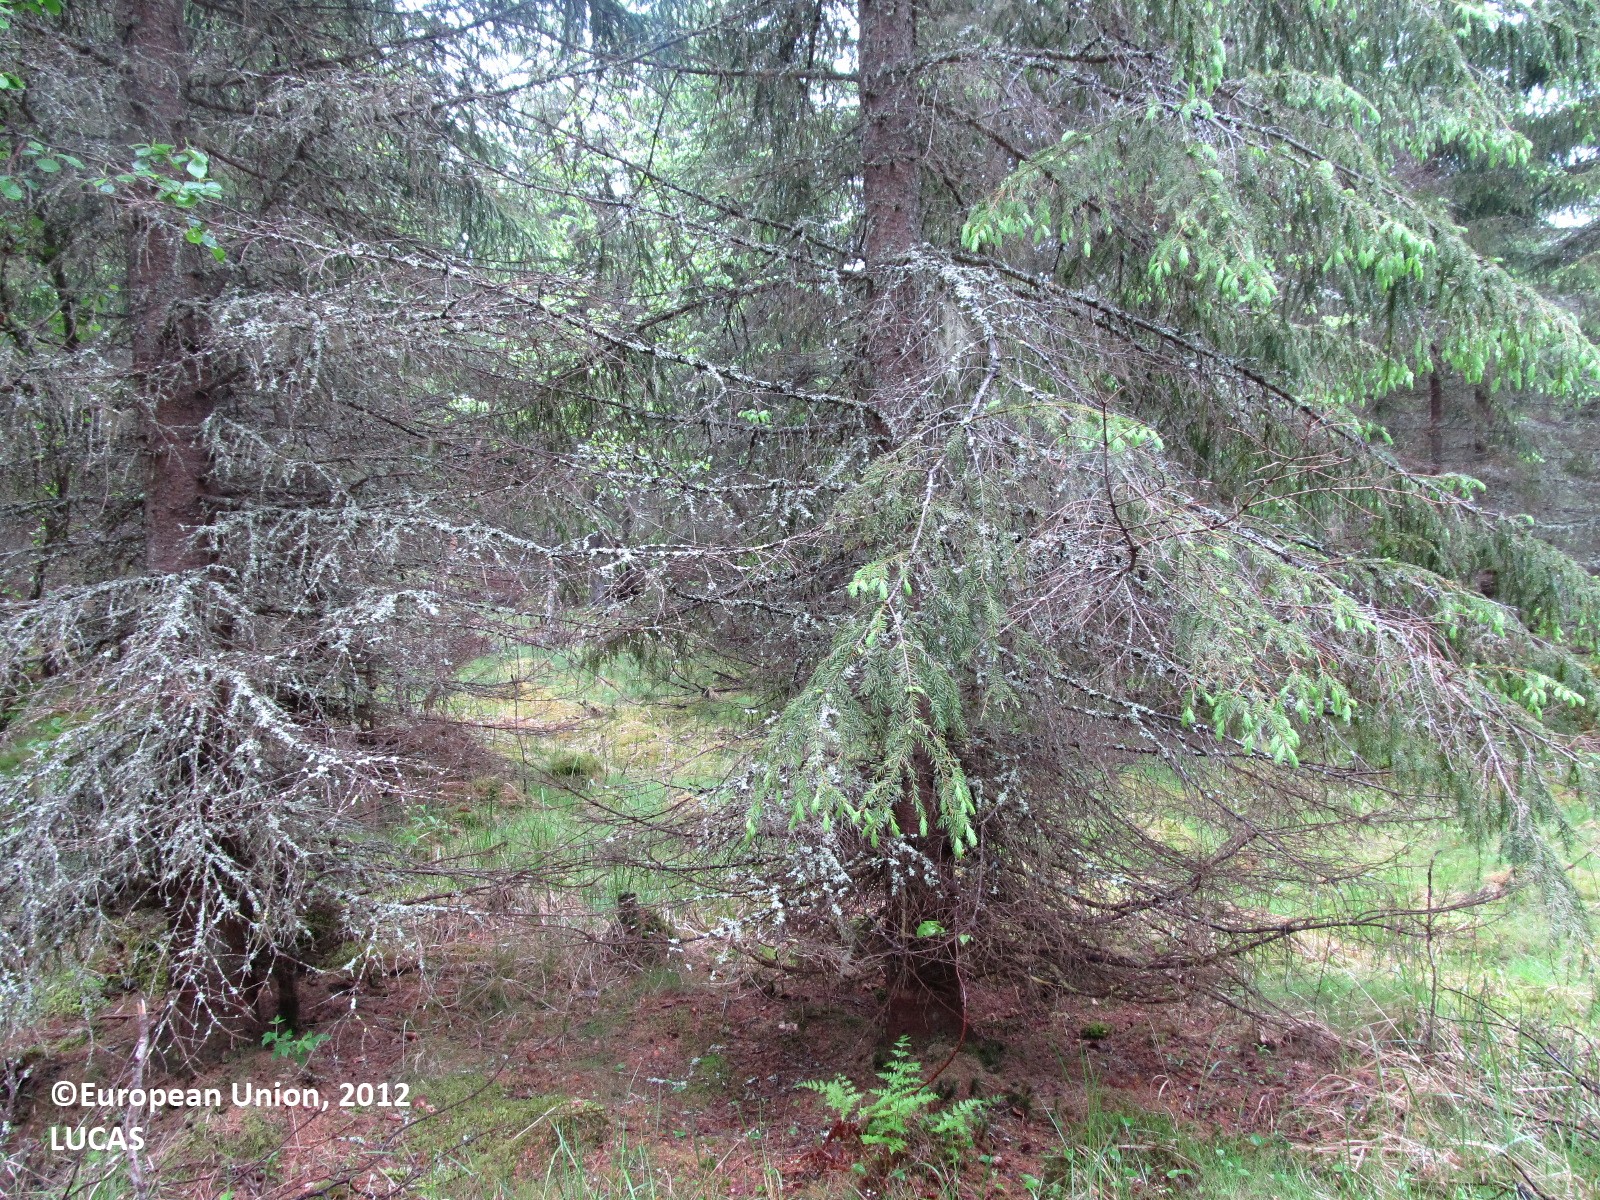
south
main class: Woodland
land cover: Spruce dominated coniferous woodland
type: boreal forest
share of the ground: 25 - 50 %
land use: Forestry
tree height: > 5 m
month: June
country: FI
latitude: 62.8437
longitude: 28.5210
